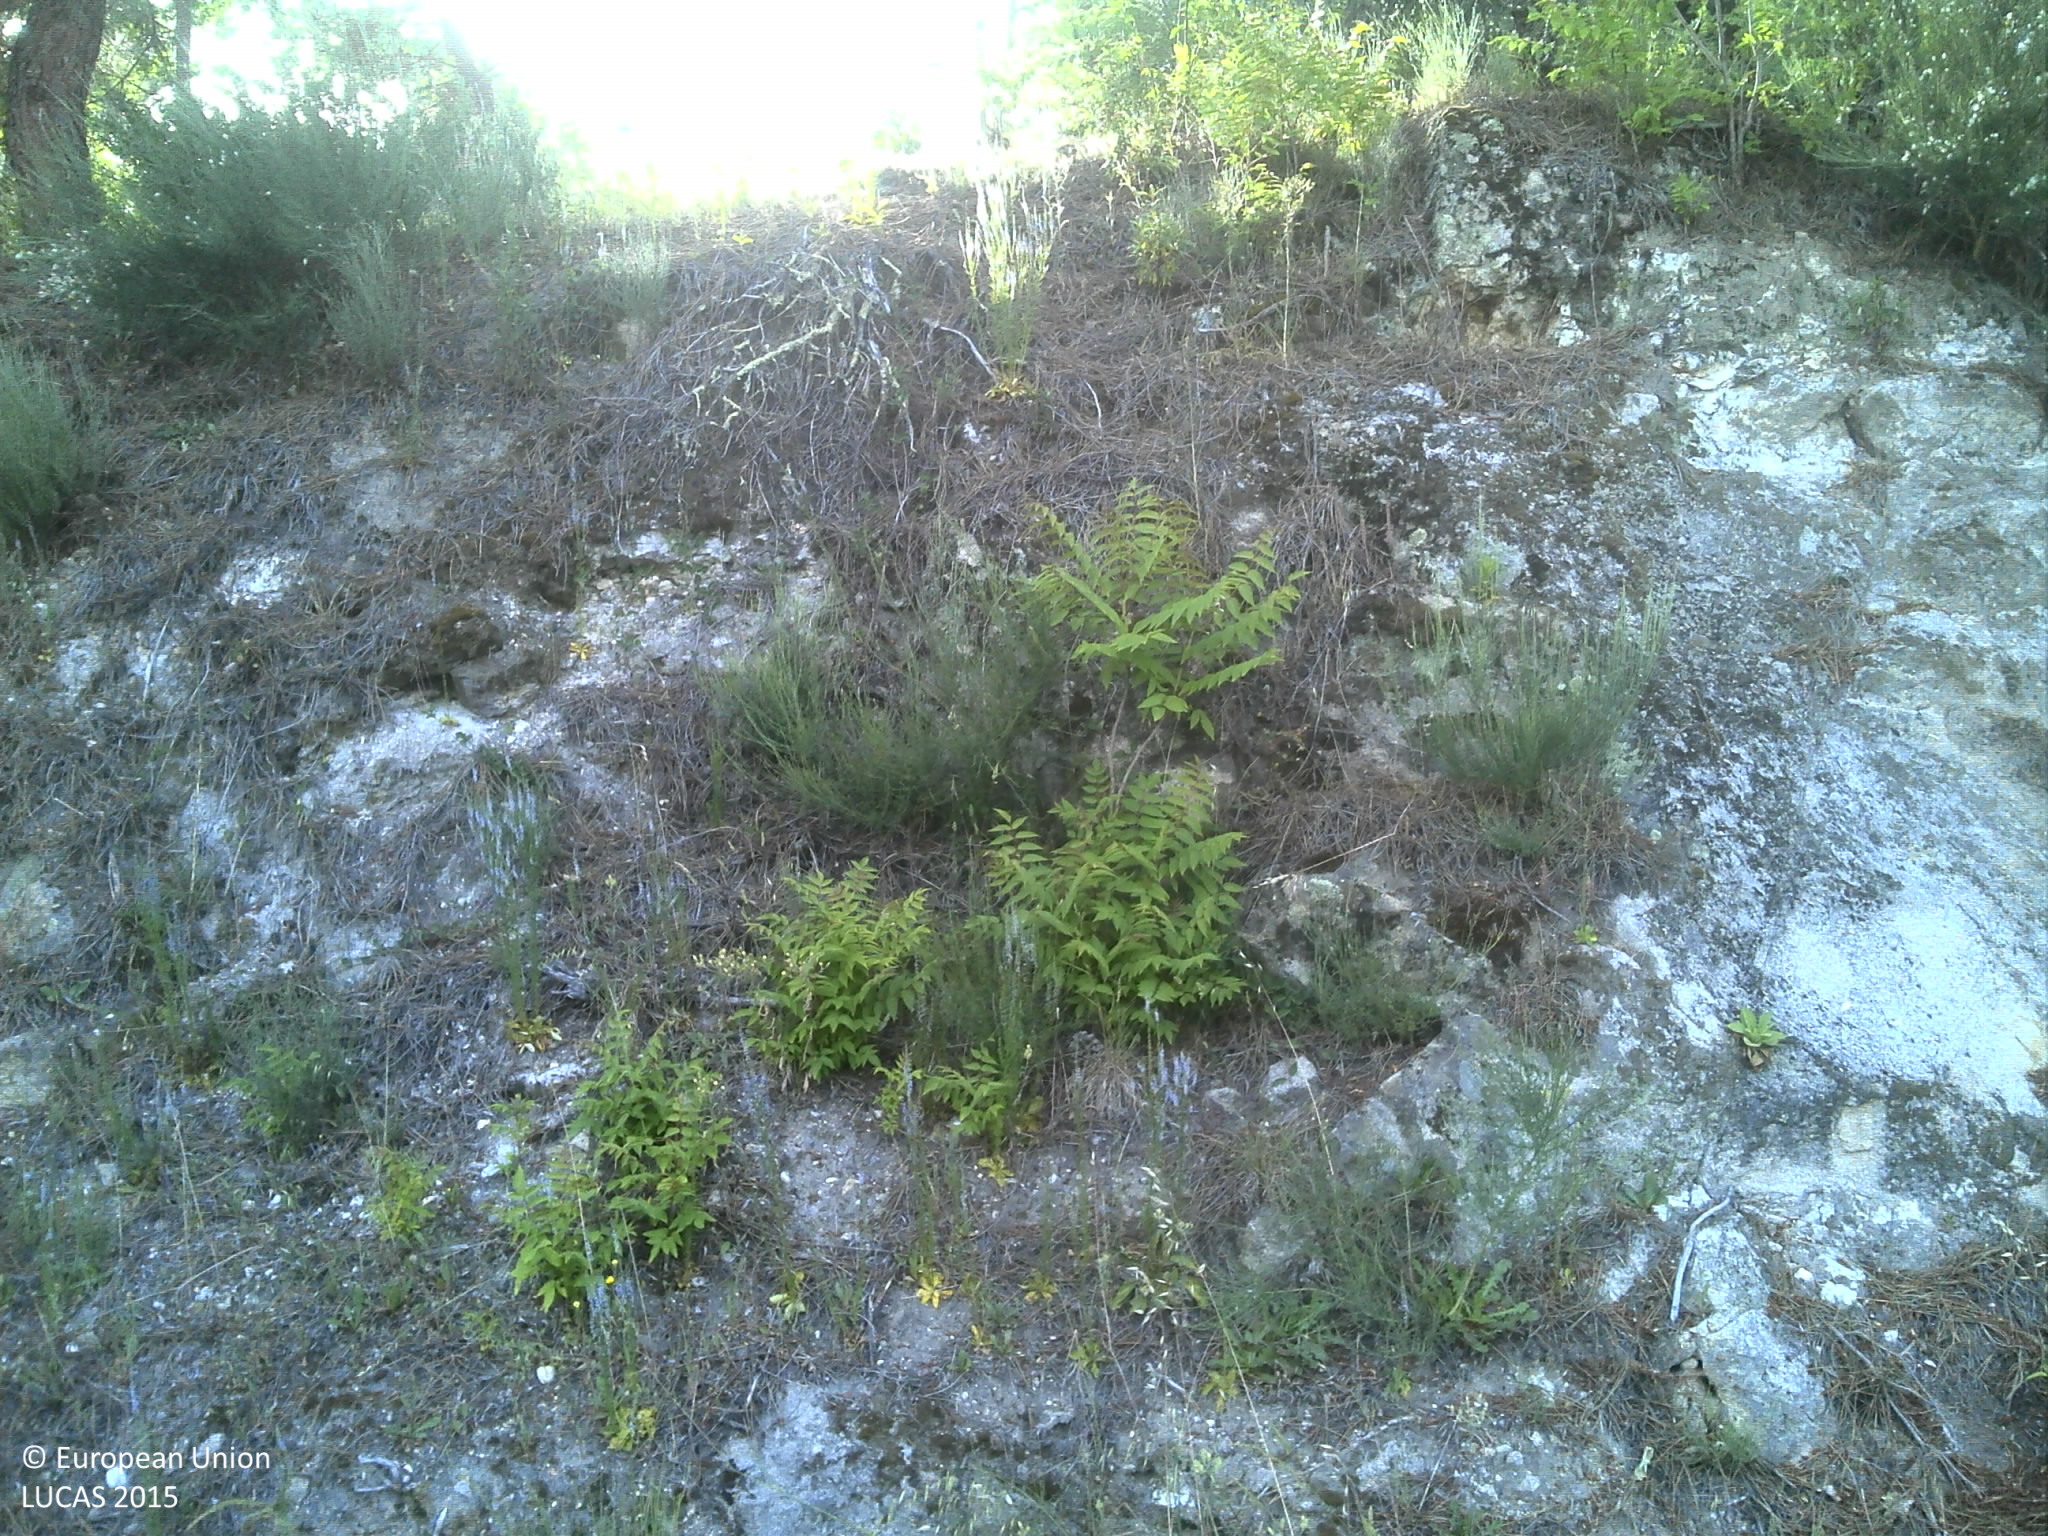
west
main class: Woodland
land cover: Pine dominated coniferous woodland
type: coniferous forest of the mediterranean region
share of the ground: 50 - 75 %
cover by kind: coniferous forest trees 65 %, shrubs 15 %, broadleaved forest trees 5 %, herbaceous plants 5 %, unconsolidated bare surface 5 %
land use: Forestry
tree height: > 5 m
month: May
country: PT
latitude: 40.6141
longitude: -7.5241
